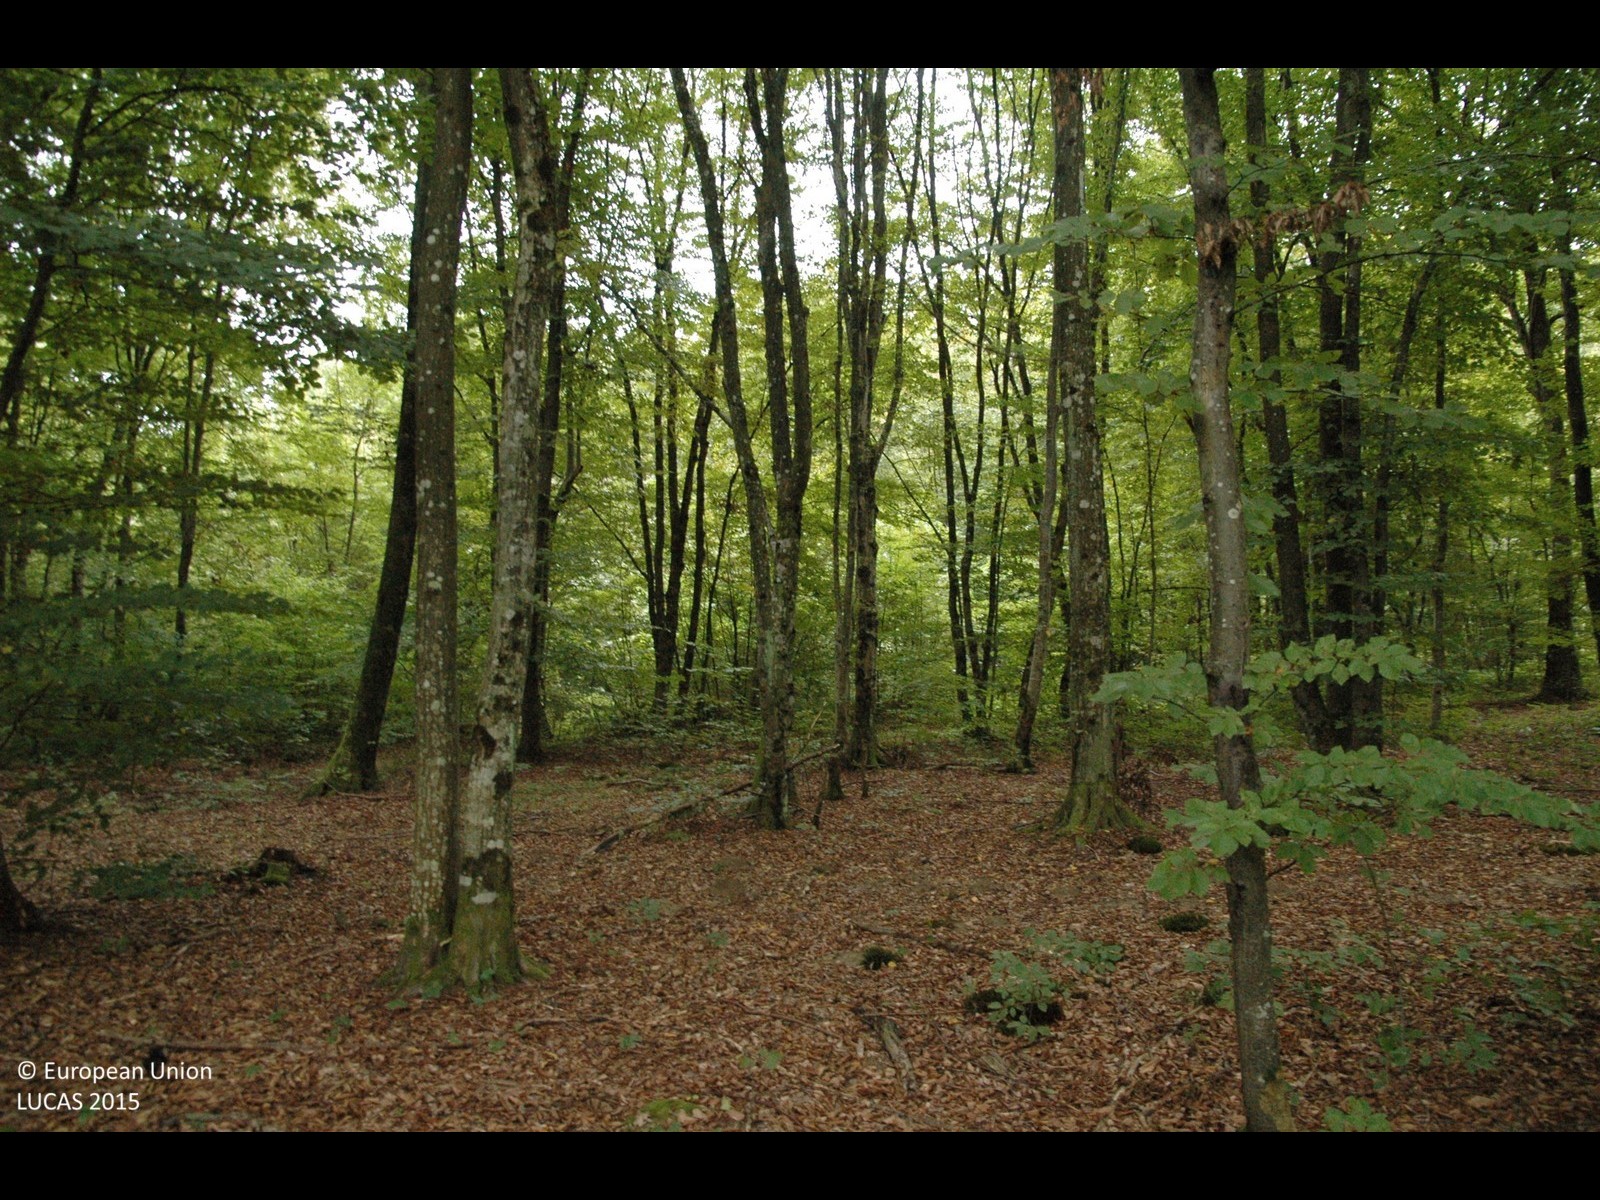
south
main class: Woodland
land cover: Broadleaved woodland
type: beech forest
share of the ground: > 75 %
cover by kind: broadleaved forest trees 100 %
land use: Forestry
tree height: > 5 m
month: October
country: HR
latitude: 45.5609
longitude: 16.1342
